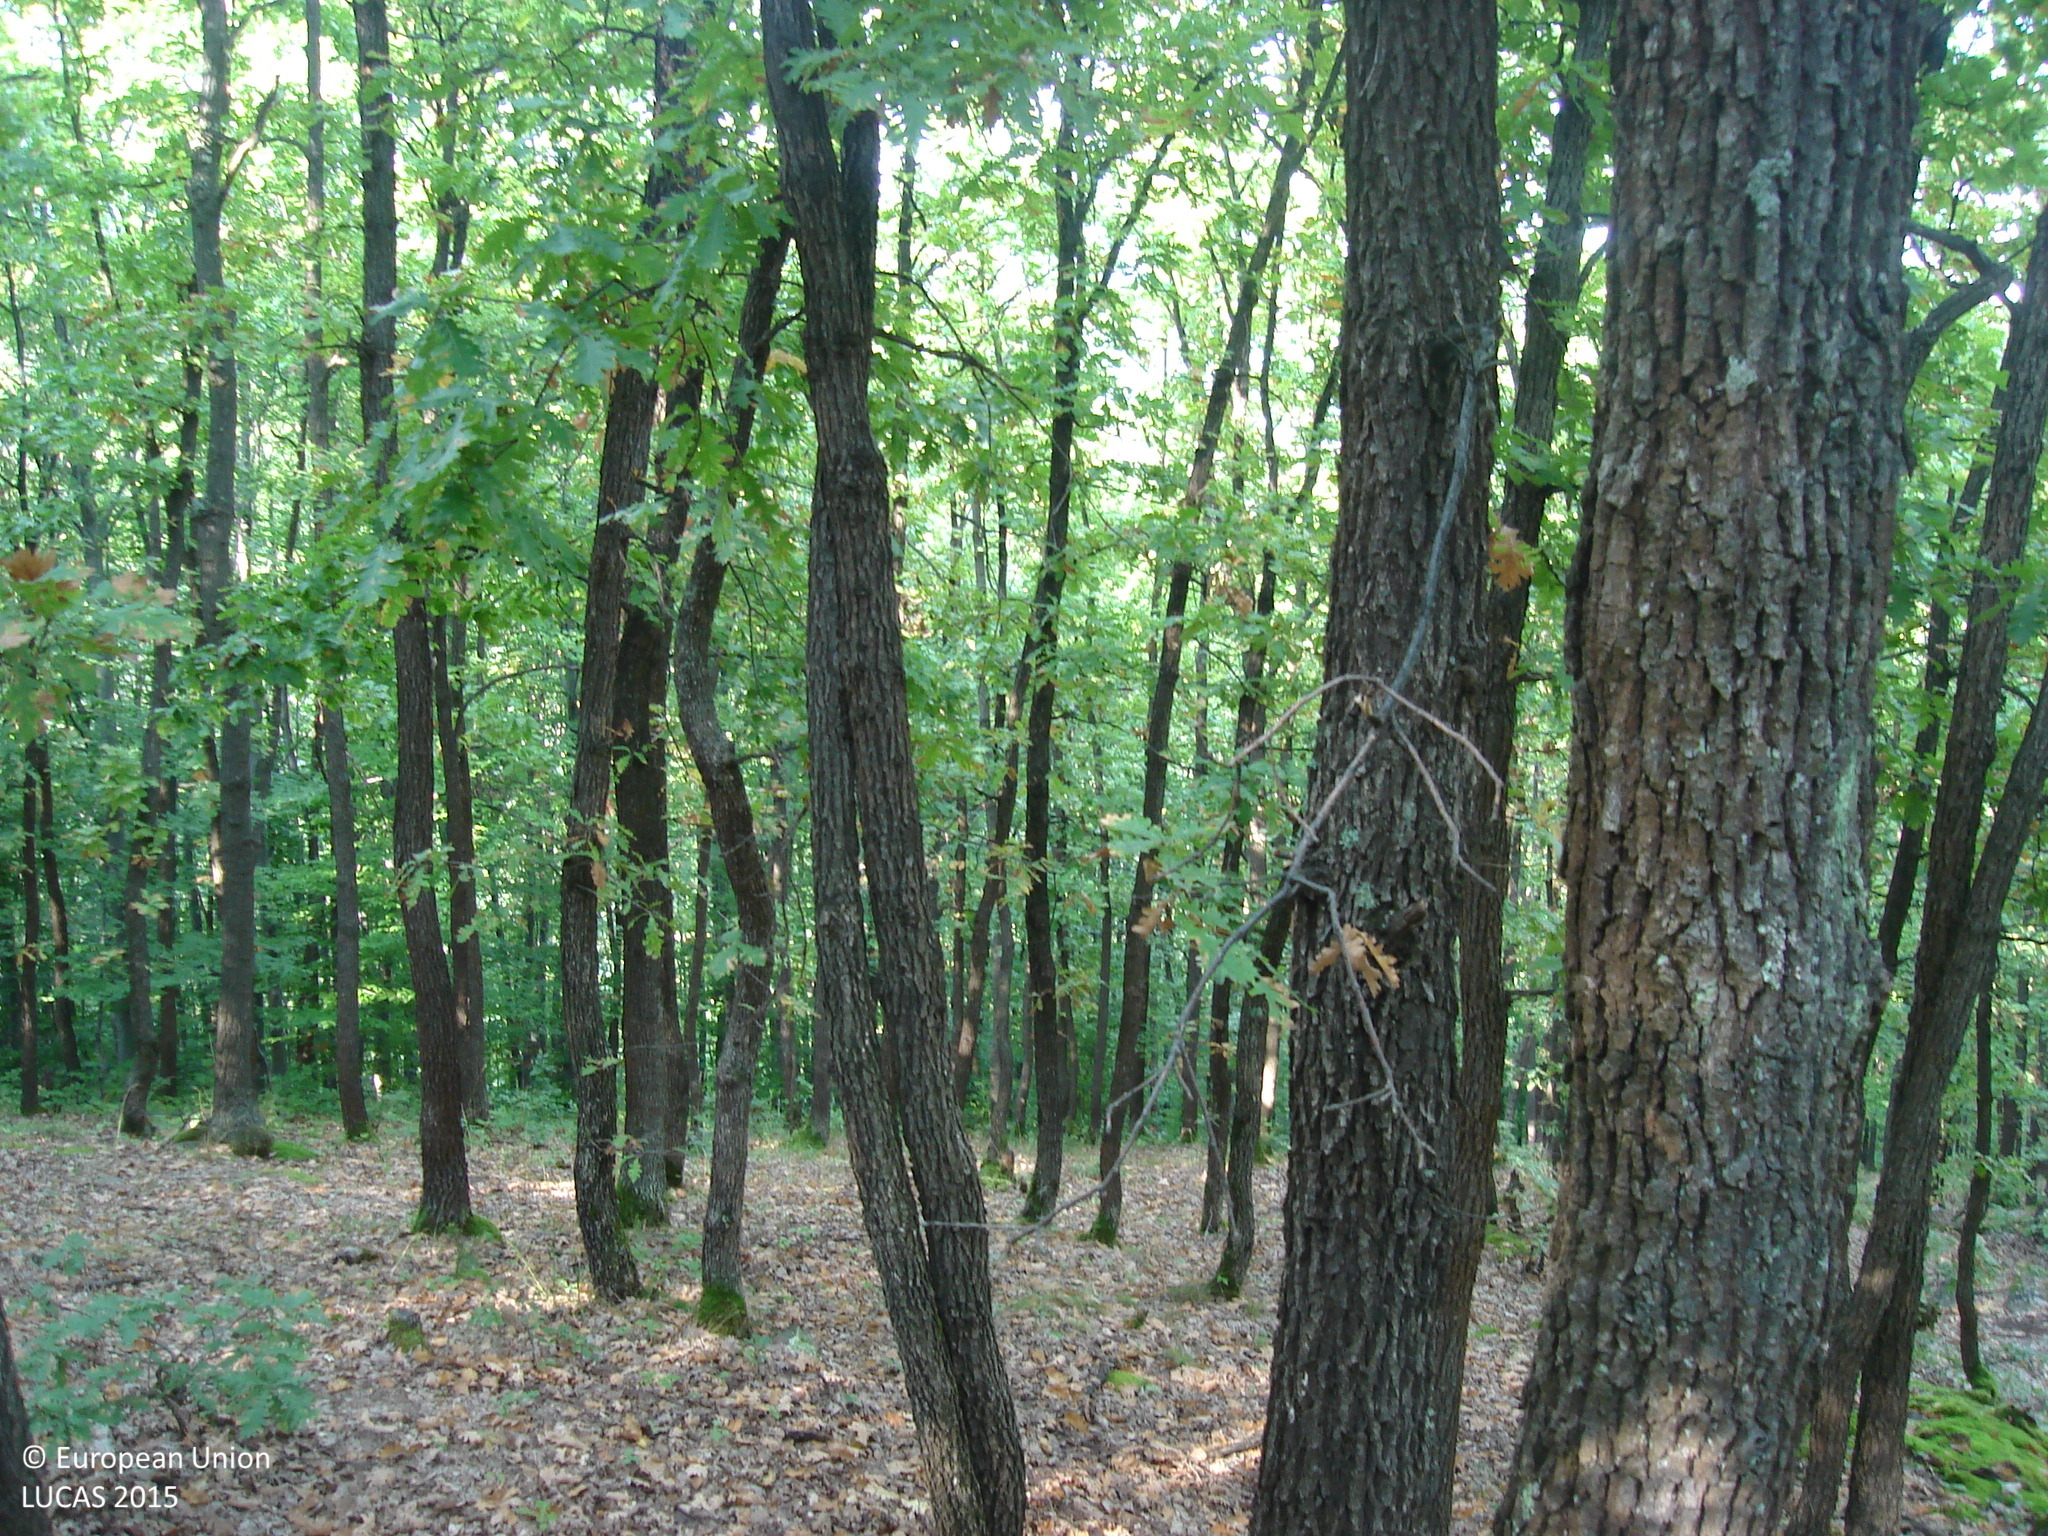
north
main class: Woodland
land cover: Broadleaved woodland
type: mesophytic deciduous forest
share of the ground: > 75 %
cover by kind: broadleaved forest trees 80 %, consolidated bare surface 20 %
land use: Forestry
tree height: > 5 m
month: September
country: BG
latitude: 42.9555
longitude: 23.3368
